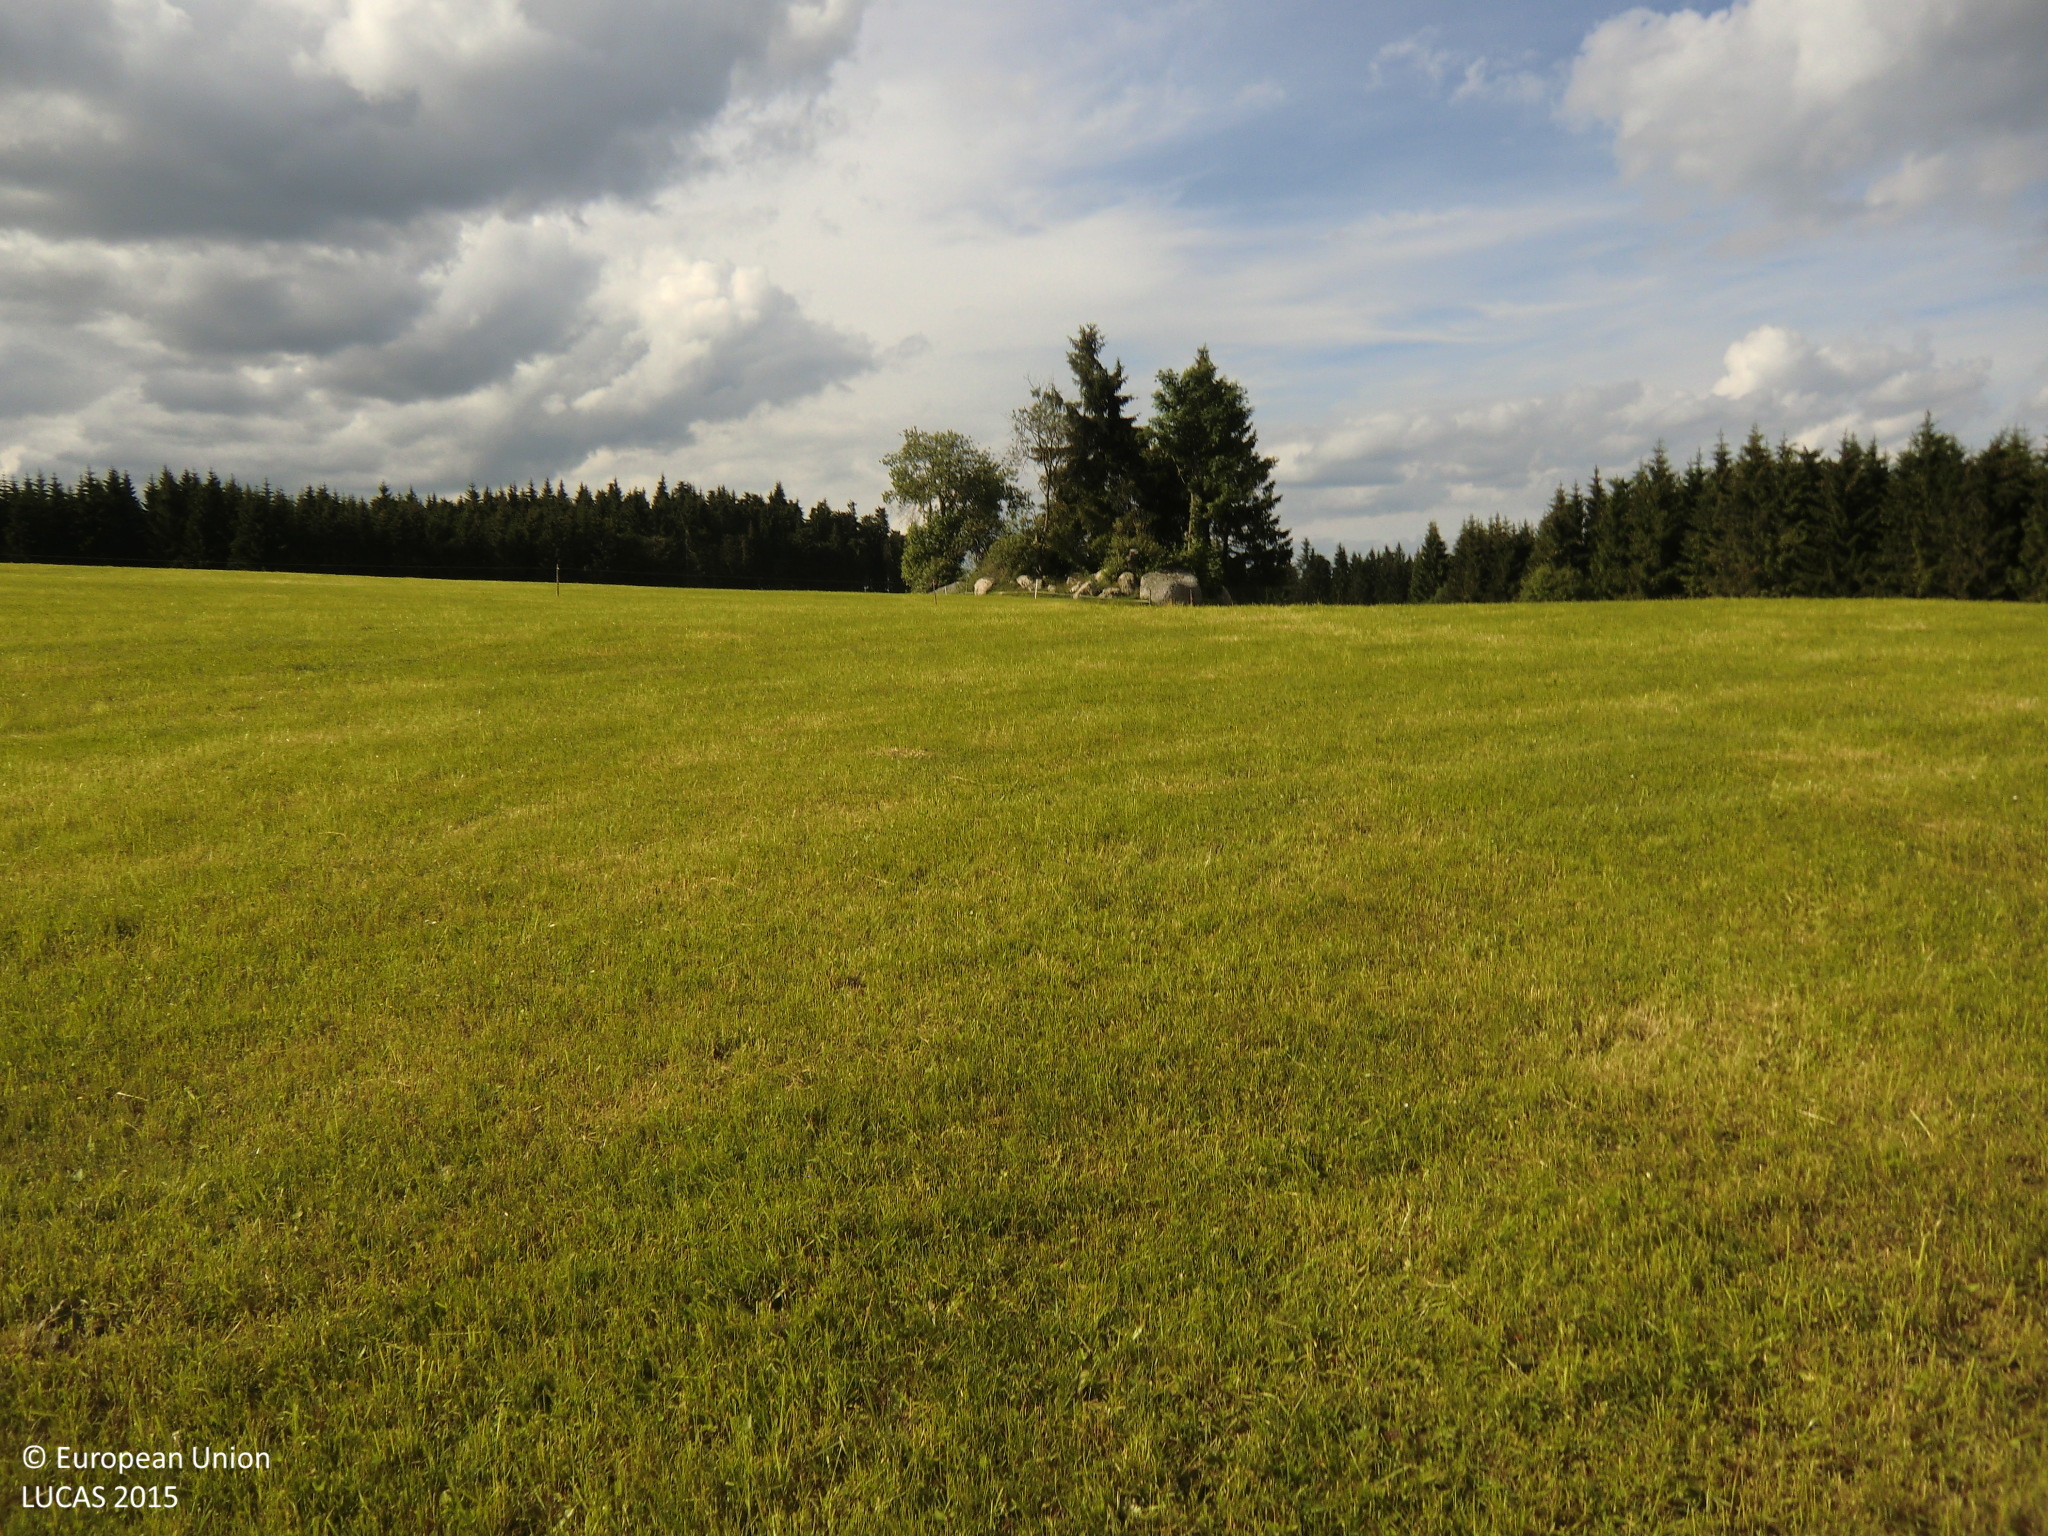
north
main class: Grassland
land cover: Grassland without tree/shrub cover
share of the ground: > 75 %
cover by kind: herbaceous plants 100 %
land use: Agriculture (excluding fallow land and kitchen gardens)
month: June
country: AT
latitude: 48.5141
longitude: 14.8342
